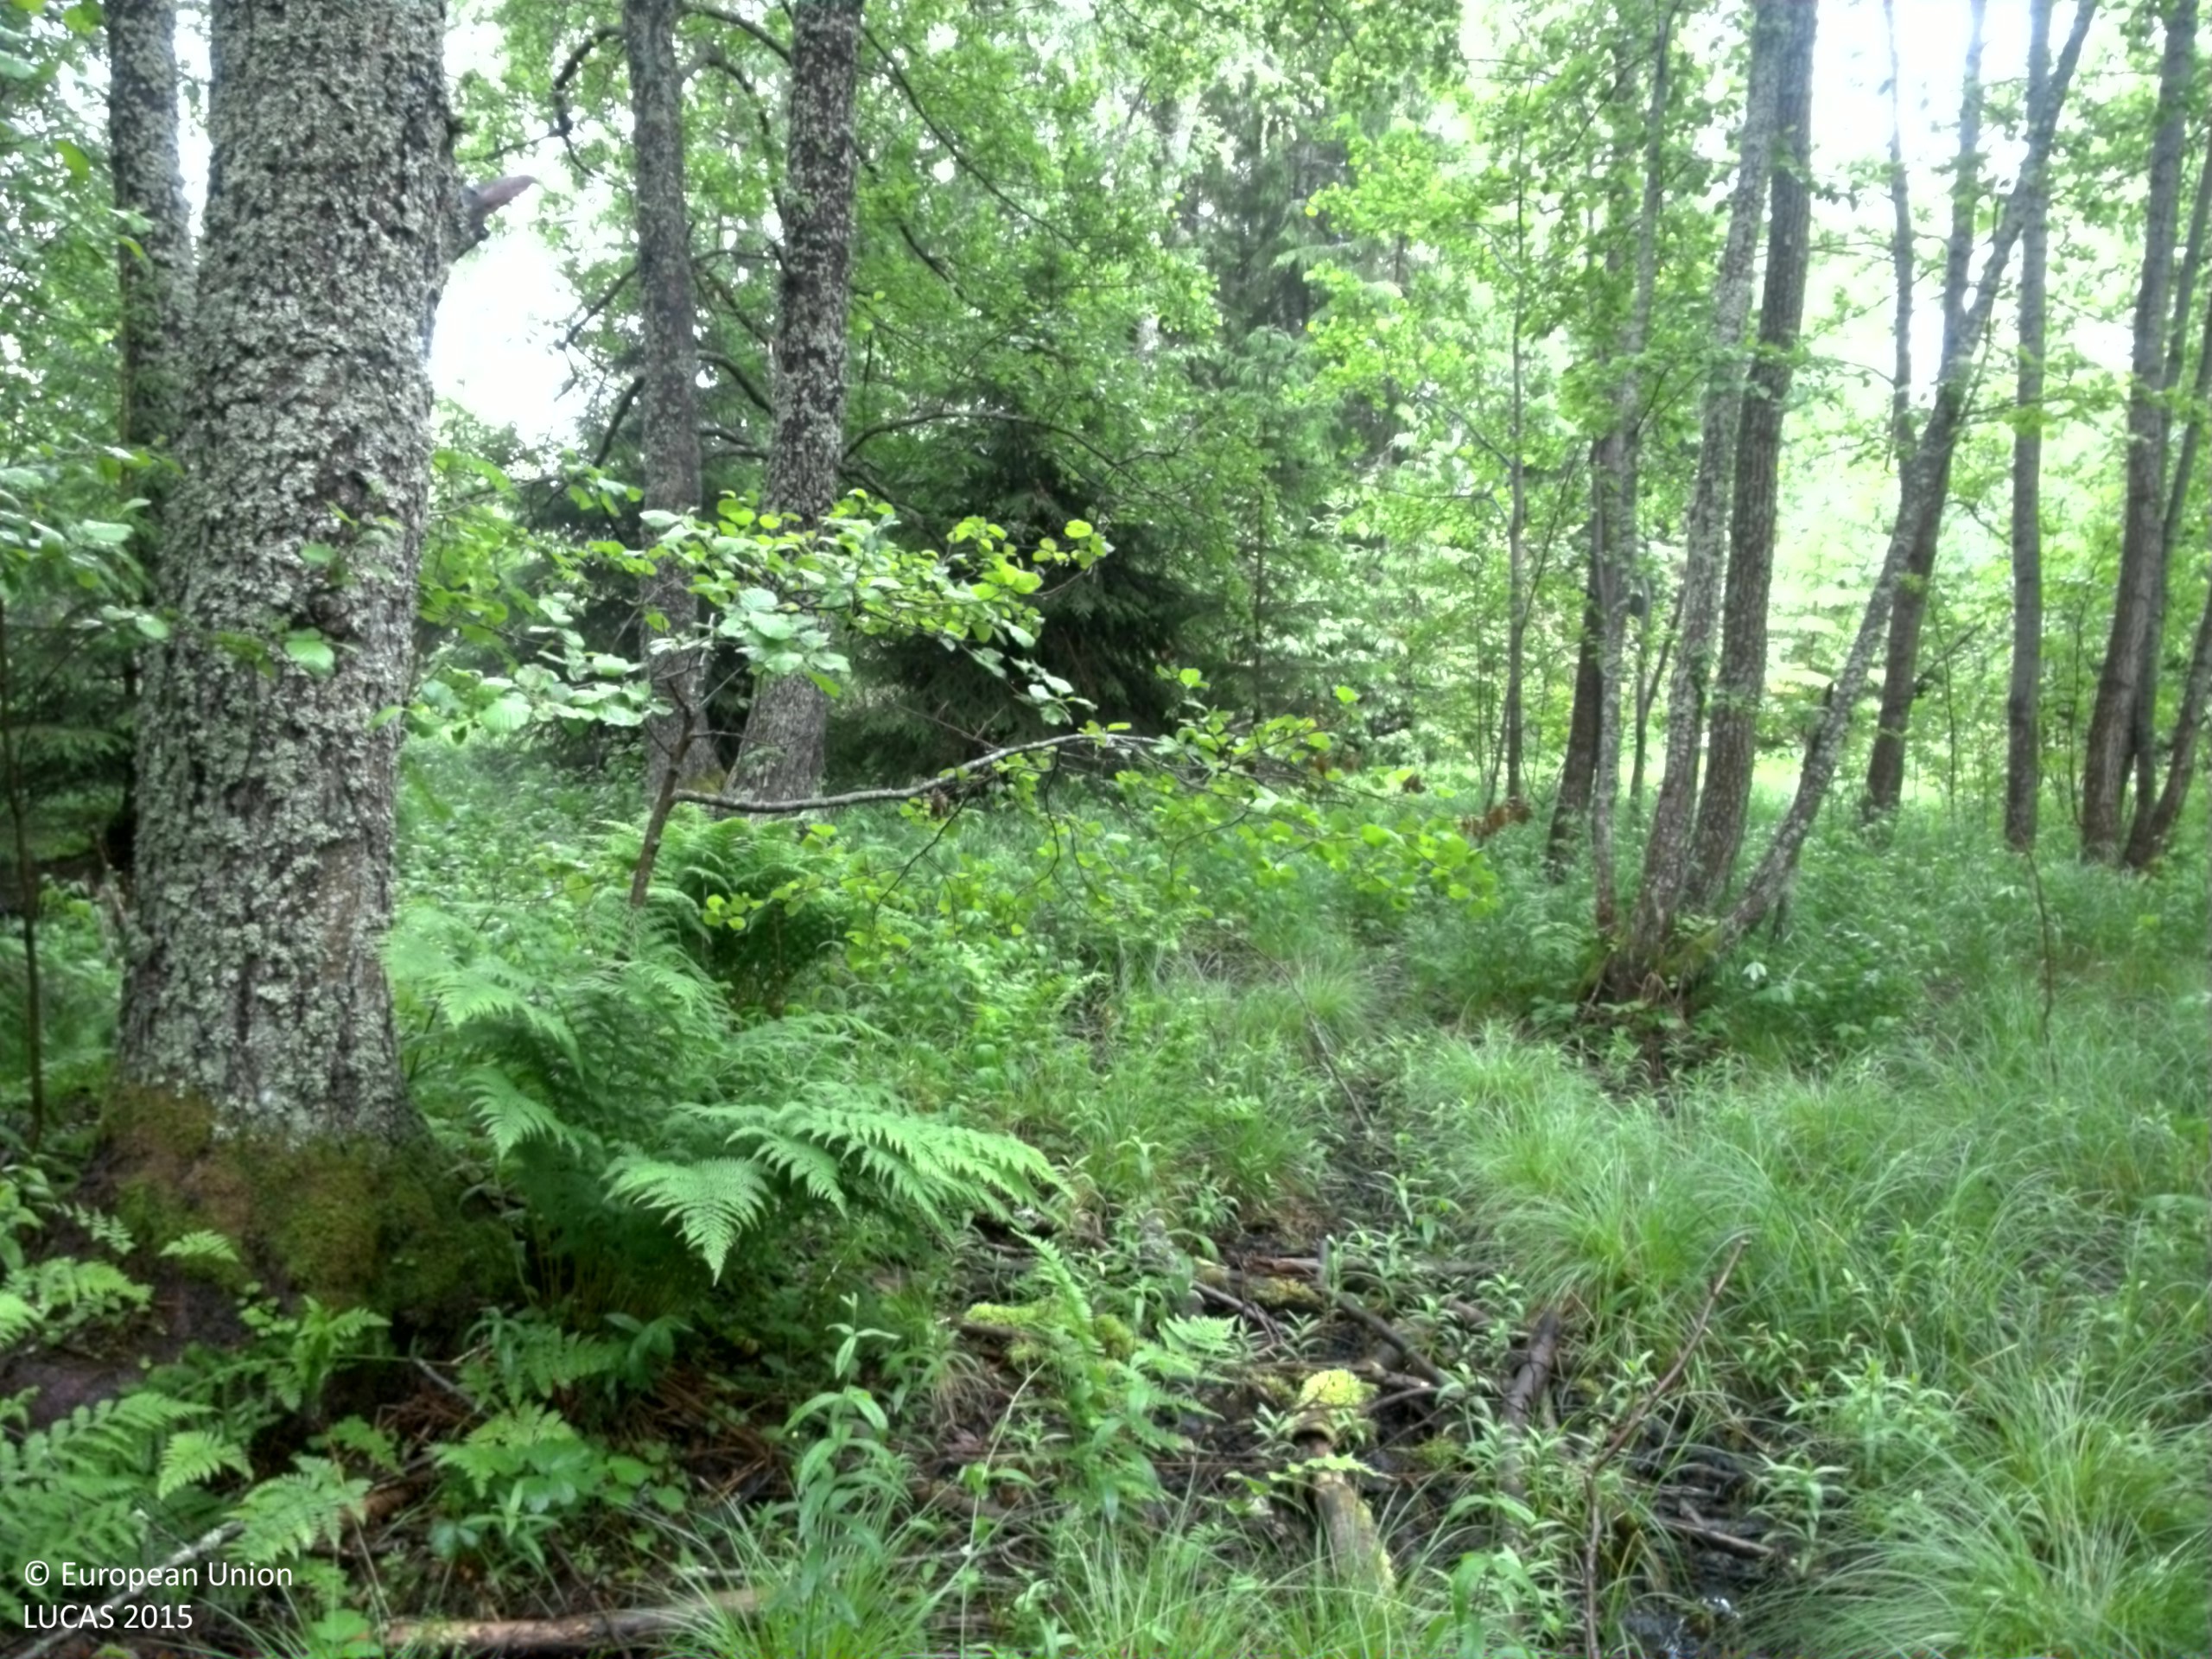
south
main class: Woodland
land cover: Broadleaved woodland
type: boreal forest
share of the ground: 50 - 75 %
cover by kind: broadleaved forest trees 50 %, herbaceous plants 25 %, coniferous forest trees 15 %, shrubs 5 %, lichens and mosses 5 %
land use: Forestry
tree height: > 5 m
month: June
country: SE
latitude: 60.4000
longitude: 18.1066
